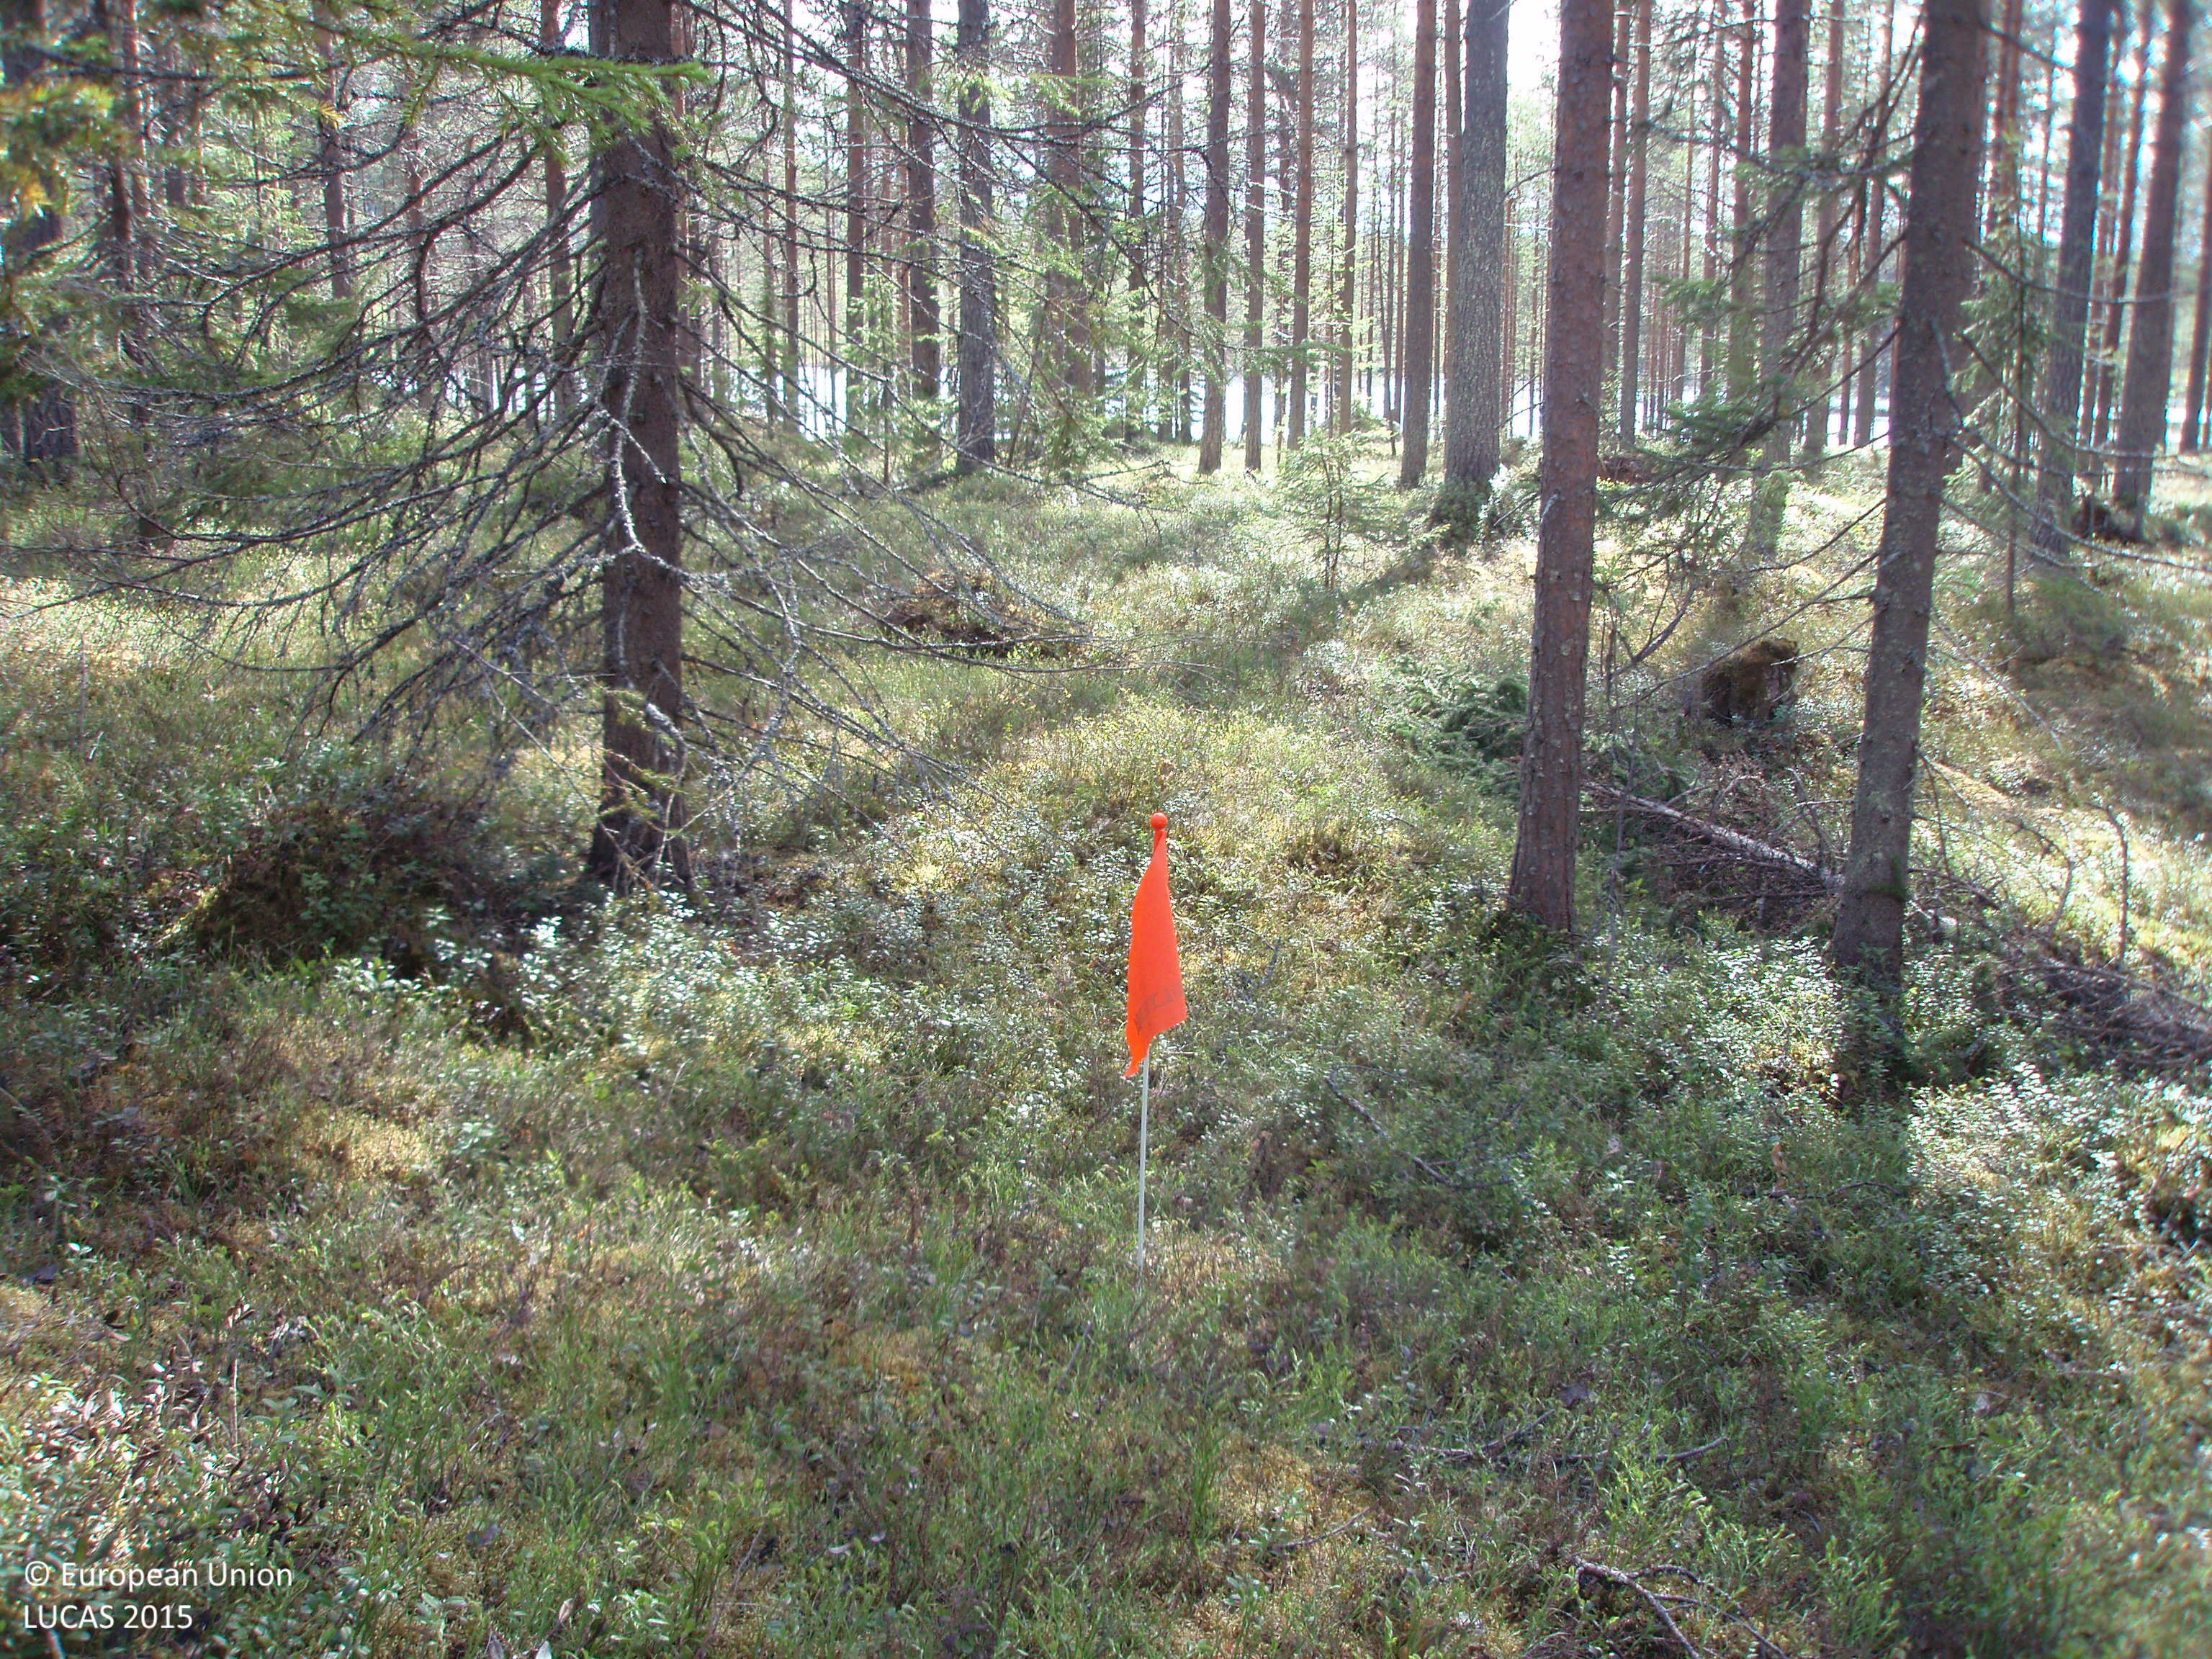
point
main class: Woodland
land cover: Pine dominated coniferous woodland
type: boreal forest
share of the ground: > 75 %
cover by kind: coniferous forest trees 75 %, shrubs 20 %, lichens and mosses 5 %
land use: Forestry
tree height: > 5 m
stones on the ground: < 10 %
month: June
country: FI
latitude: 66.7270
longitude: 26.9934
